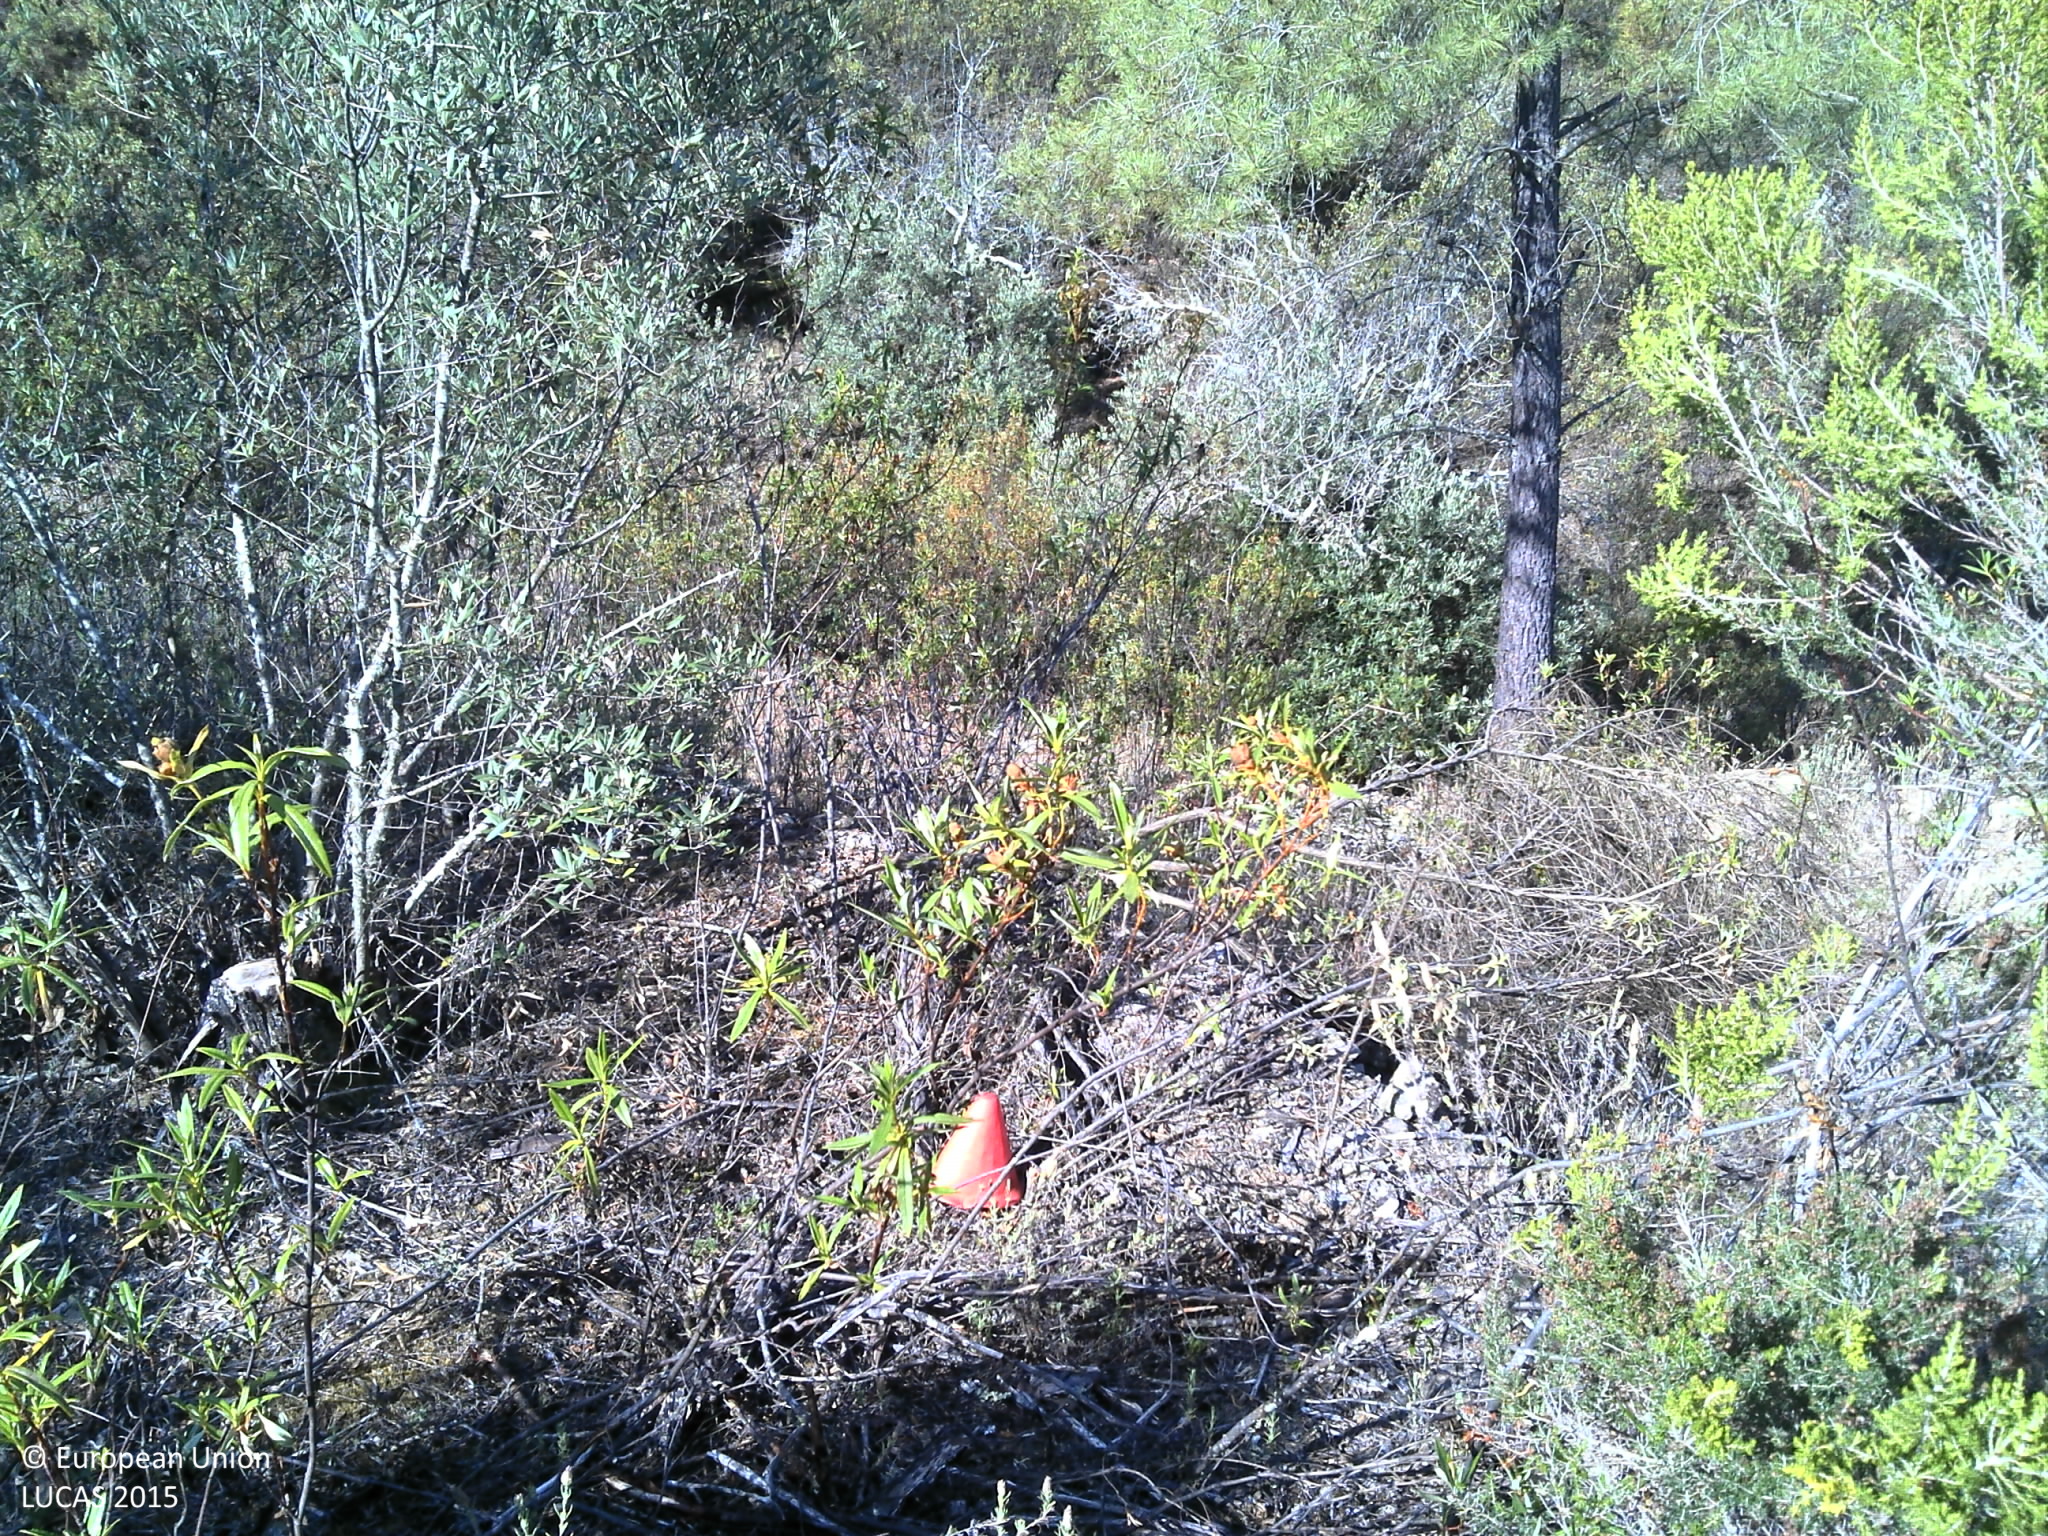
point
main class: Shrubland
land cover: Shrubland with sparse tree cover
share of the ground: 50 - 75 %
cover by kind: shrubs 60 %, unconsolidated bare surface 35 %, coniferous forest trees 5 %
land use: Semi-natural and natural areas not in use
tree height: < 5 m
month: July
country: PT
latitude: 39.5095
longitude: -7.9100
